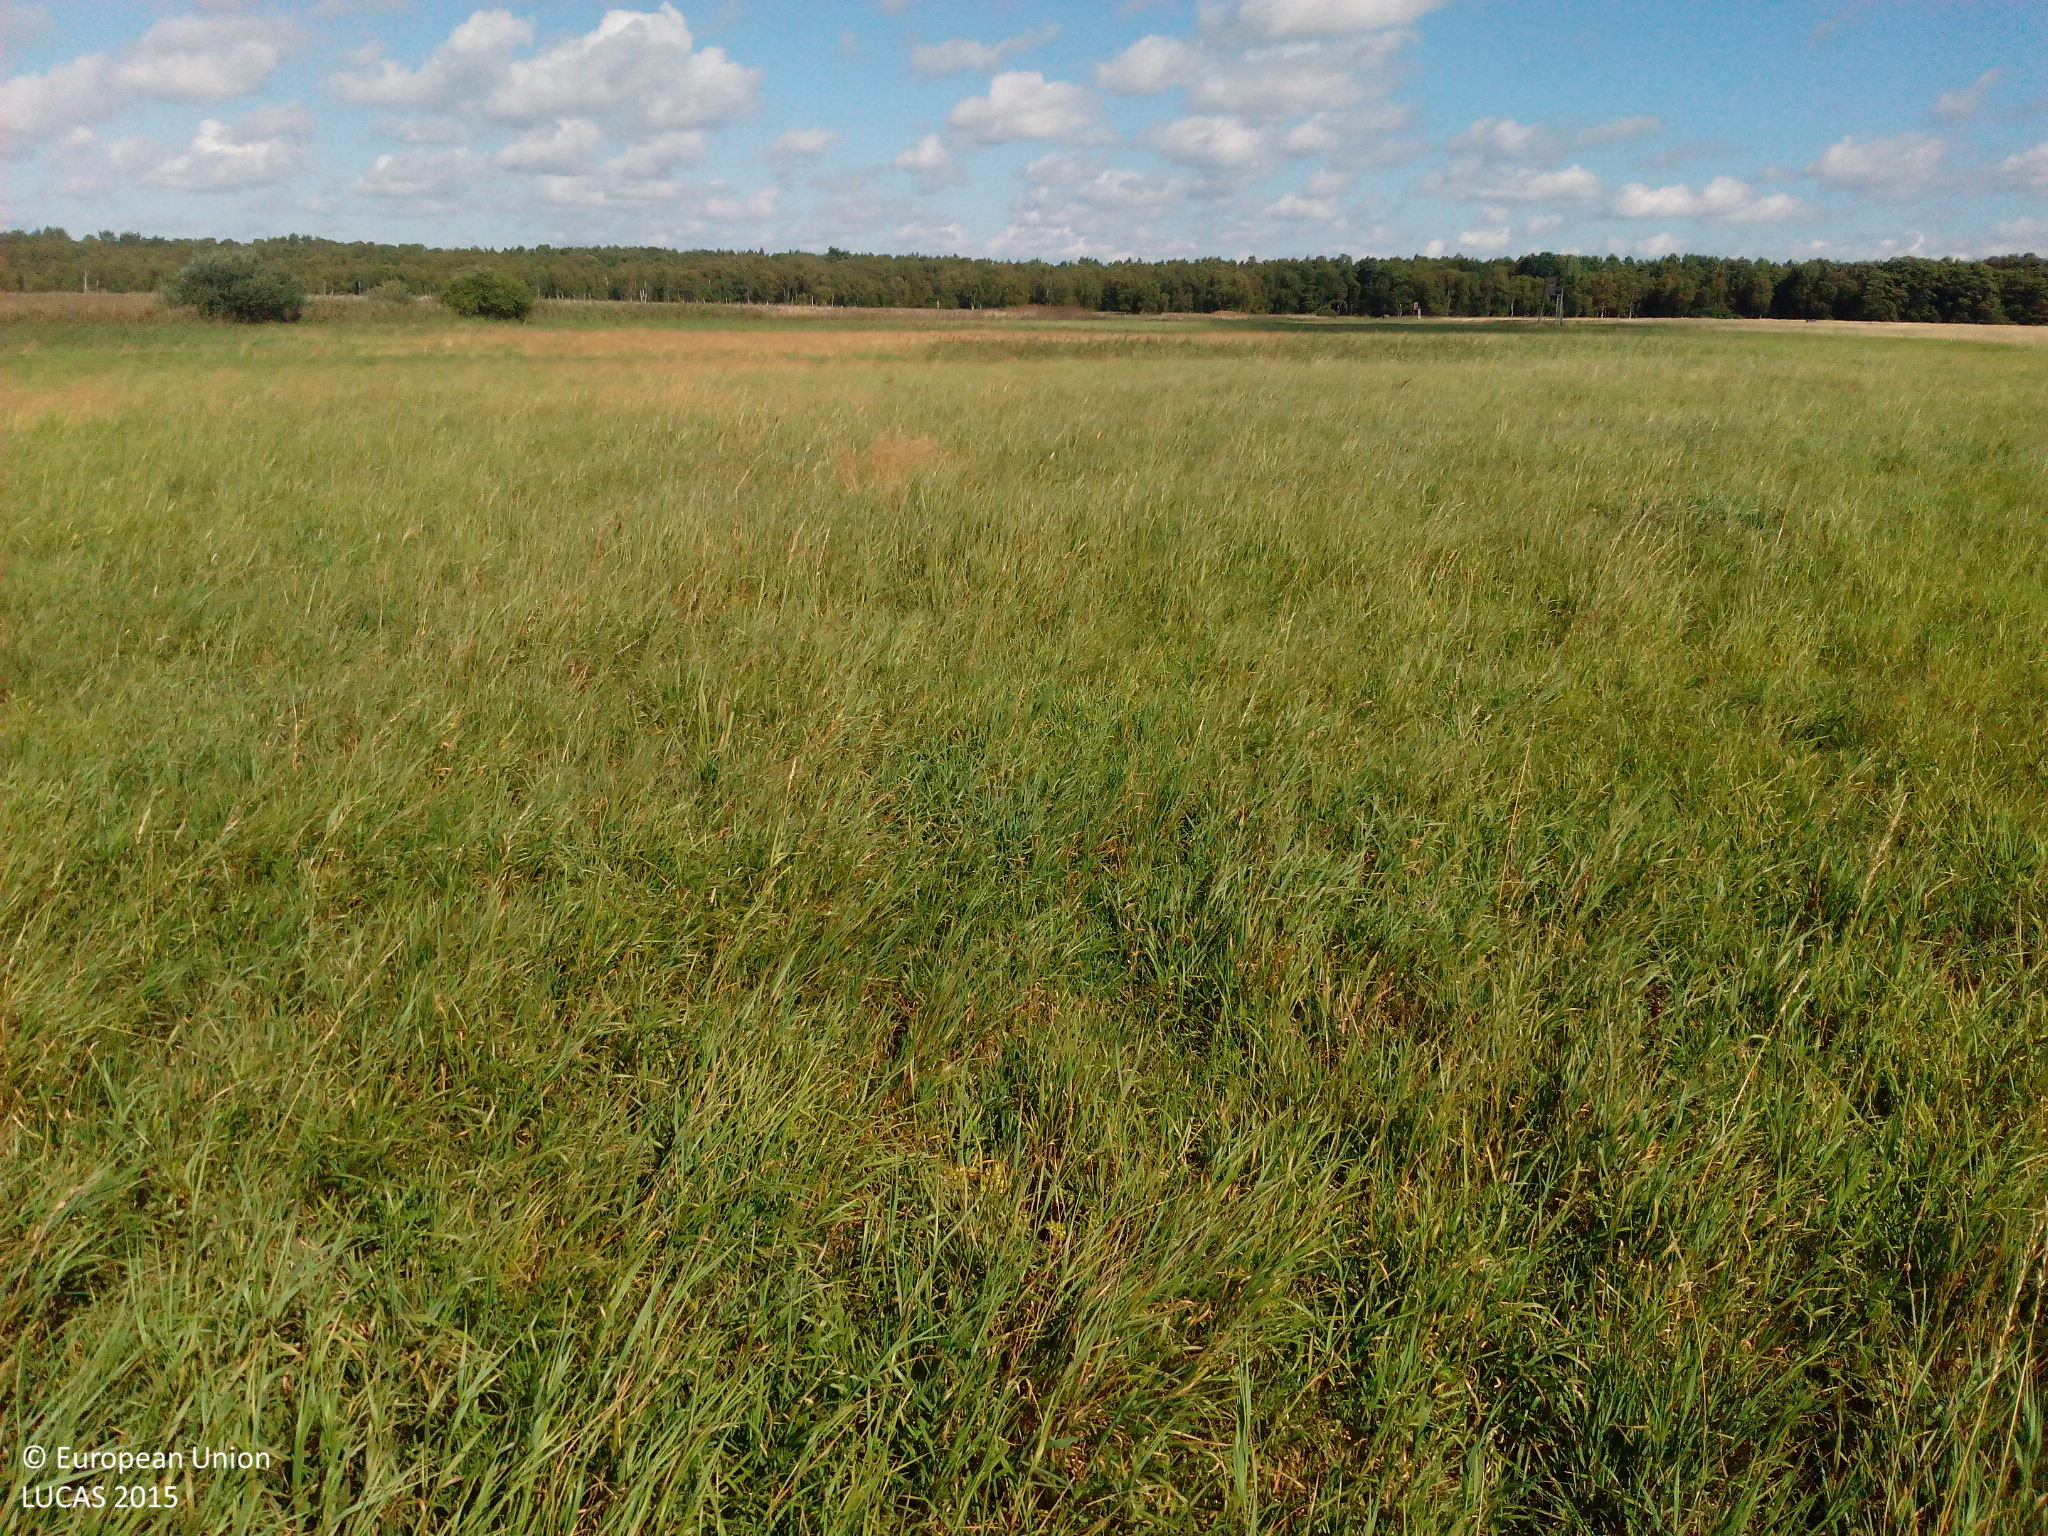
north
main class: Grassland
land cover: Grassland without tree/shrub cover
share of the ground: > 75 %
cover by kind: herbaceous plants 100 %
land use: Agriculture (excluding fallow land and kitchen gardens)
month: September
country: DE
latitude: 53.9908
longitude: 12.3327
